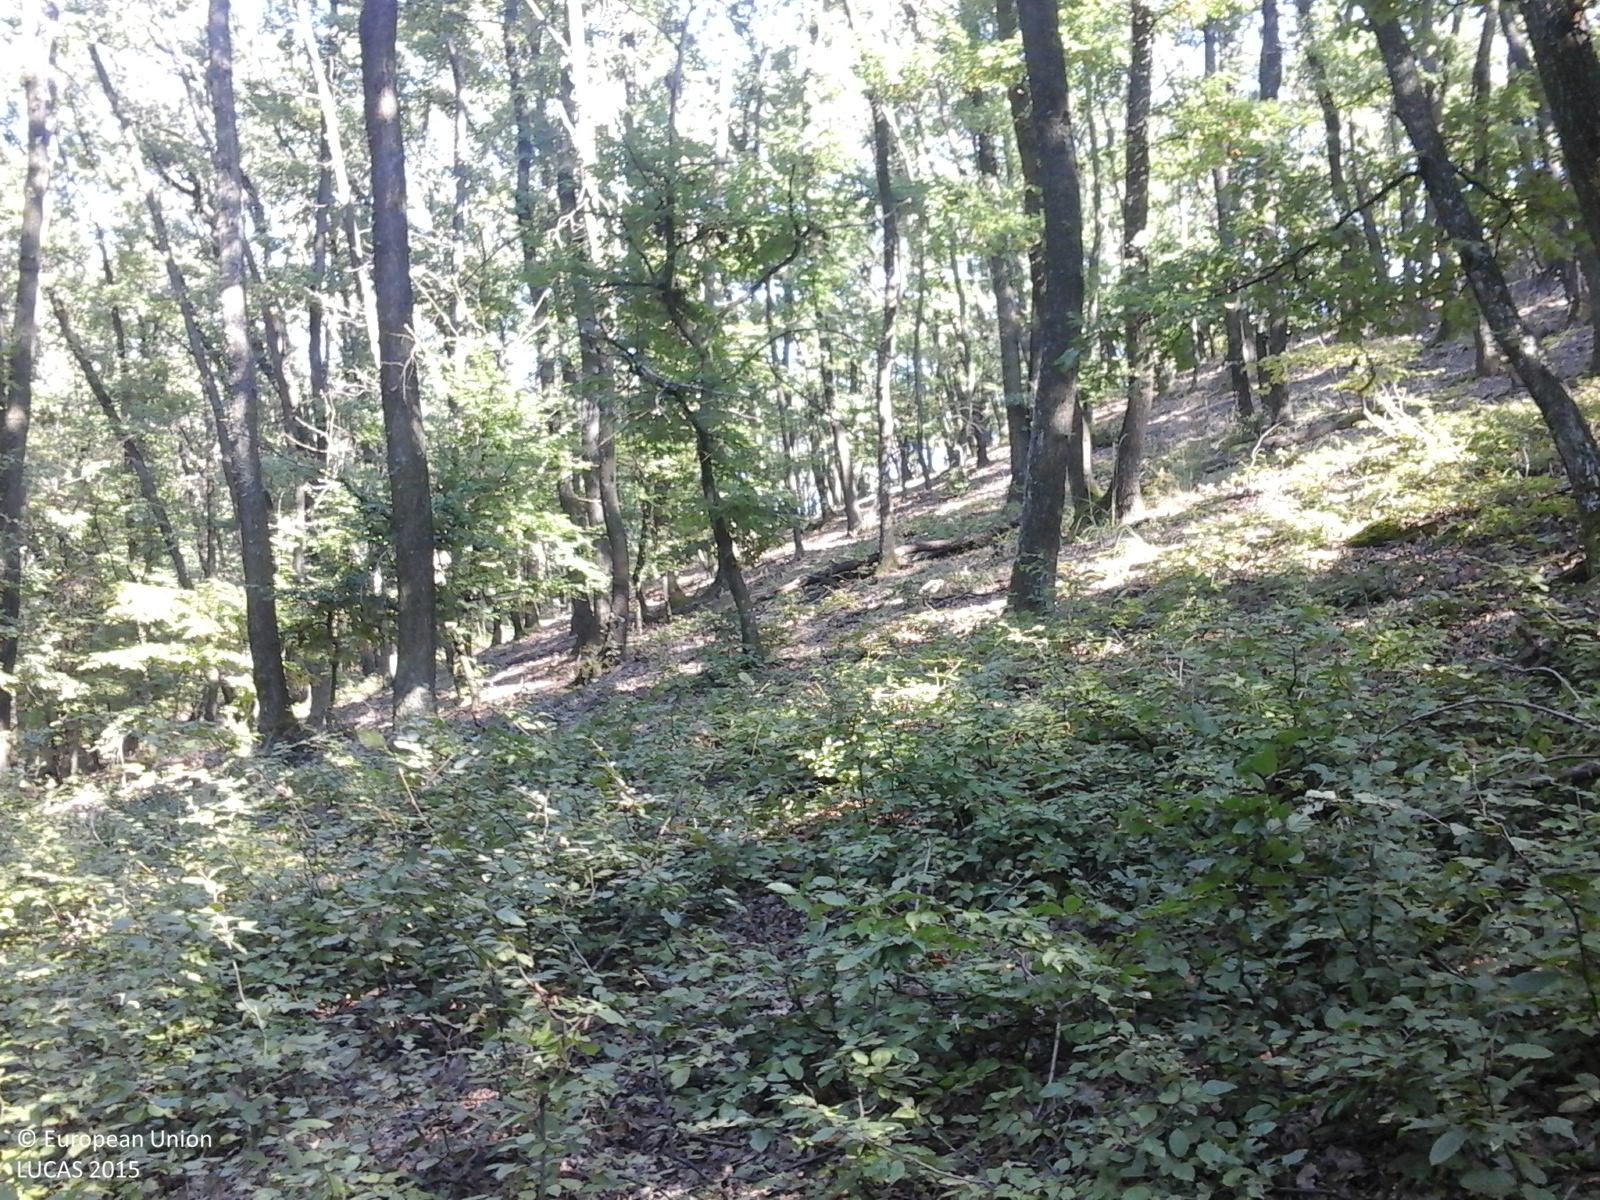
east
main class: Woodland
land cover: Broadleaved woodland
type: acidophilous oak and oak-birch forest
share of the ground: > 75 %
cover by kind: broadleaved forest trees 90 %, herbaceous plants 10 %
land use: Forestry
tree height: > 5 m
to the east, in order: Broadleaved woodland; Grassland without tree/shrub cover; Broadleaved woodland; Grassland without tree/shrub cover
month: October
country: RO
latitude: 46.3069
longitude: 23.8227
